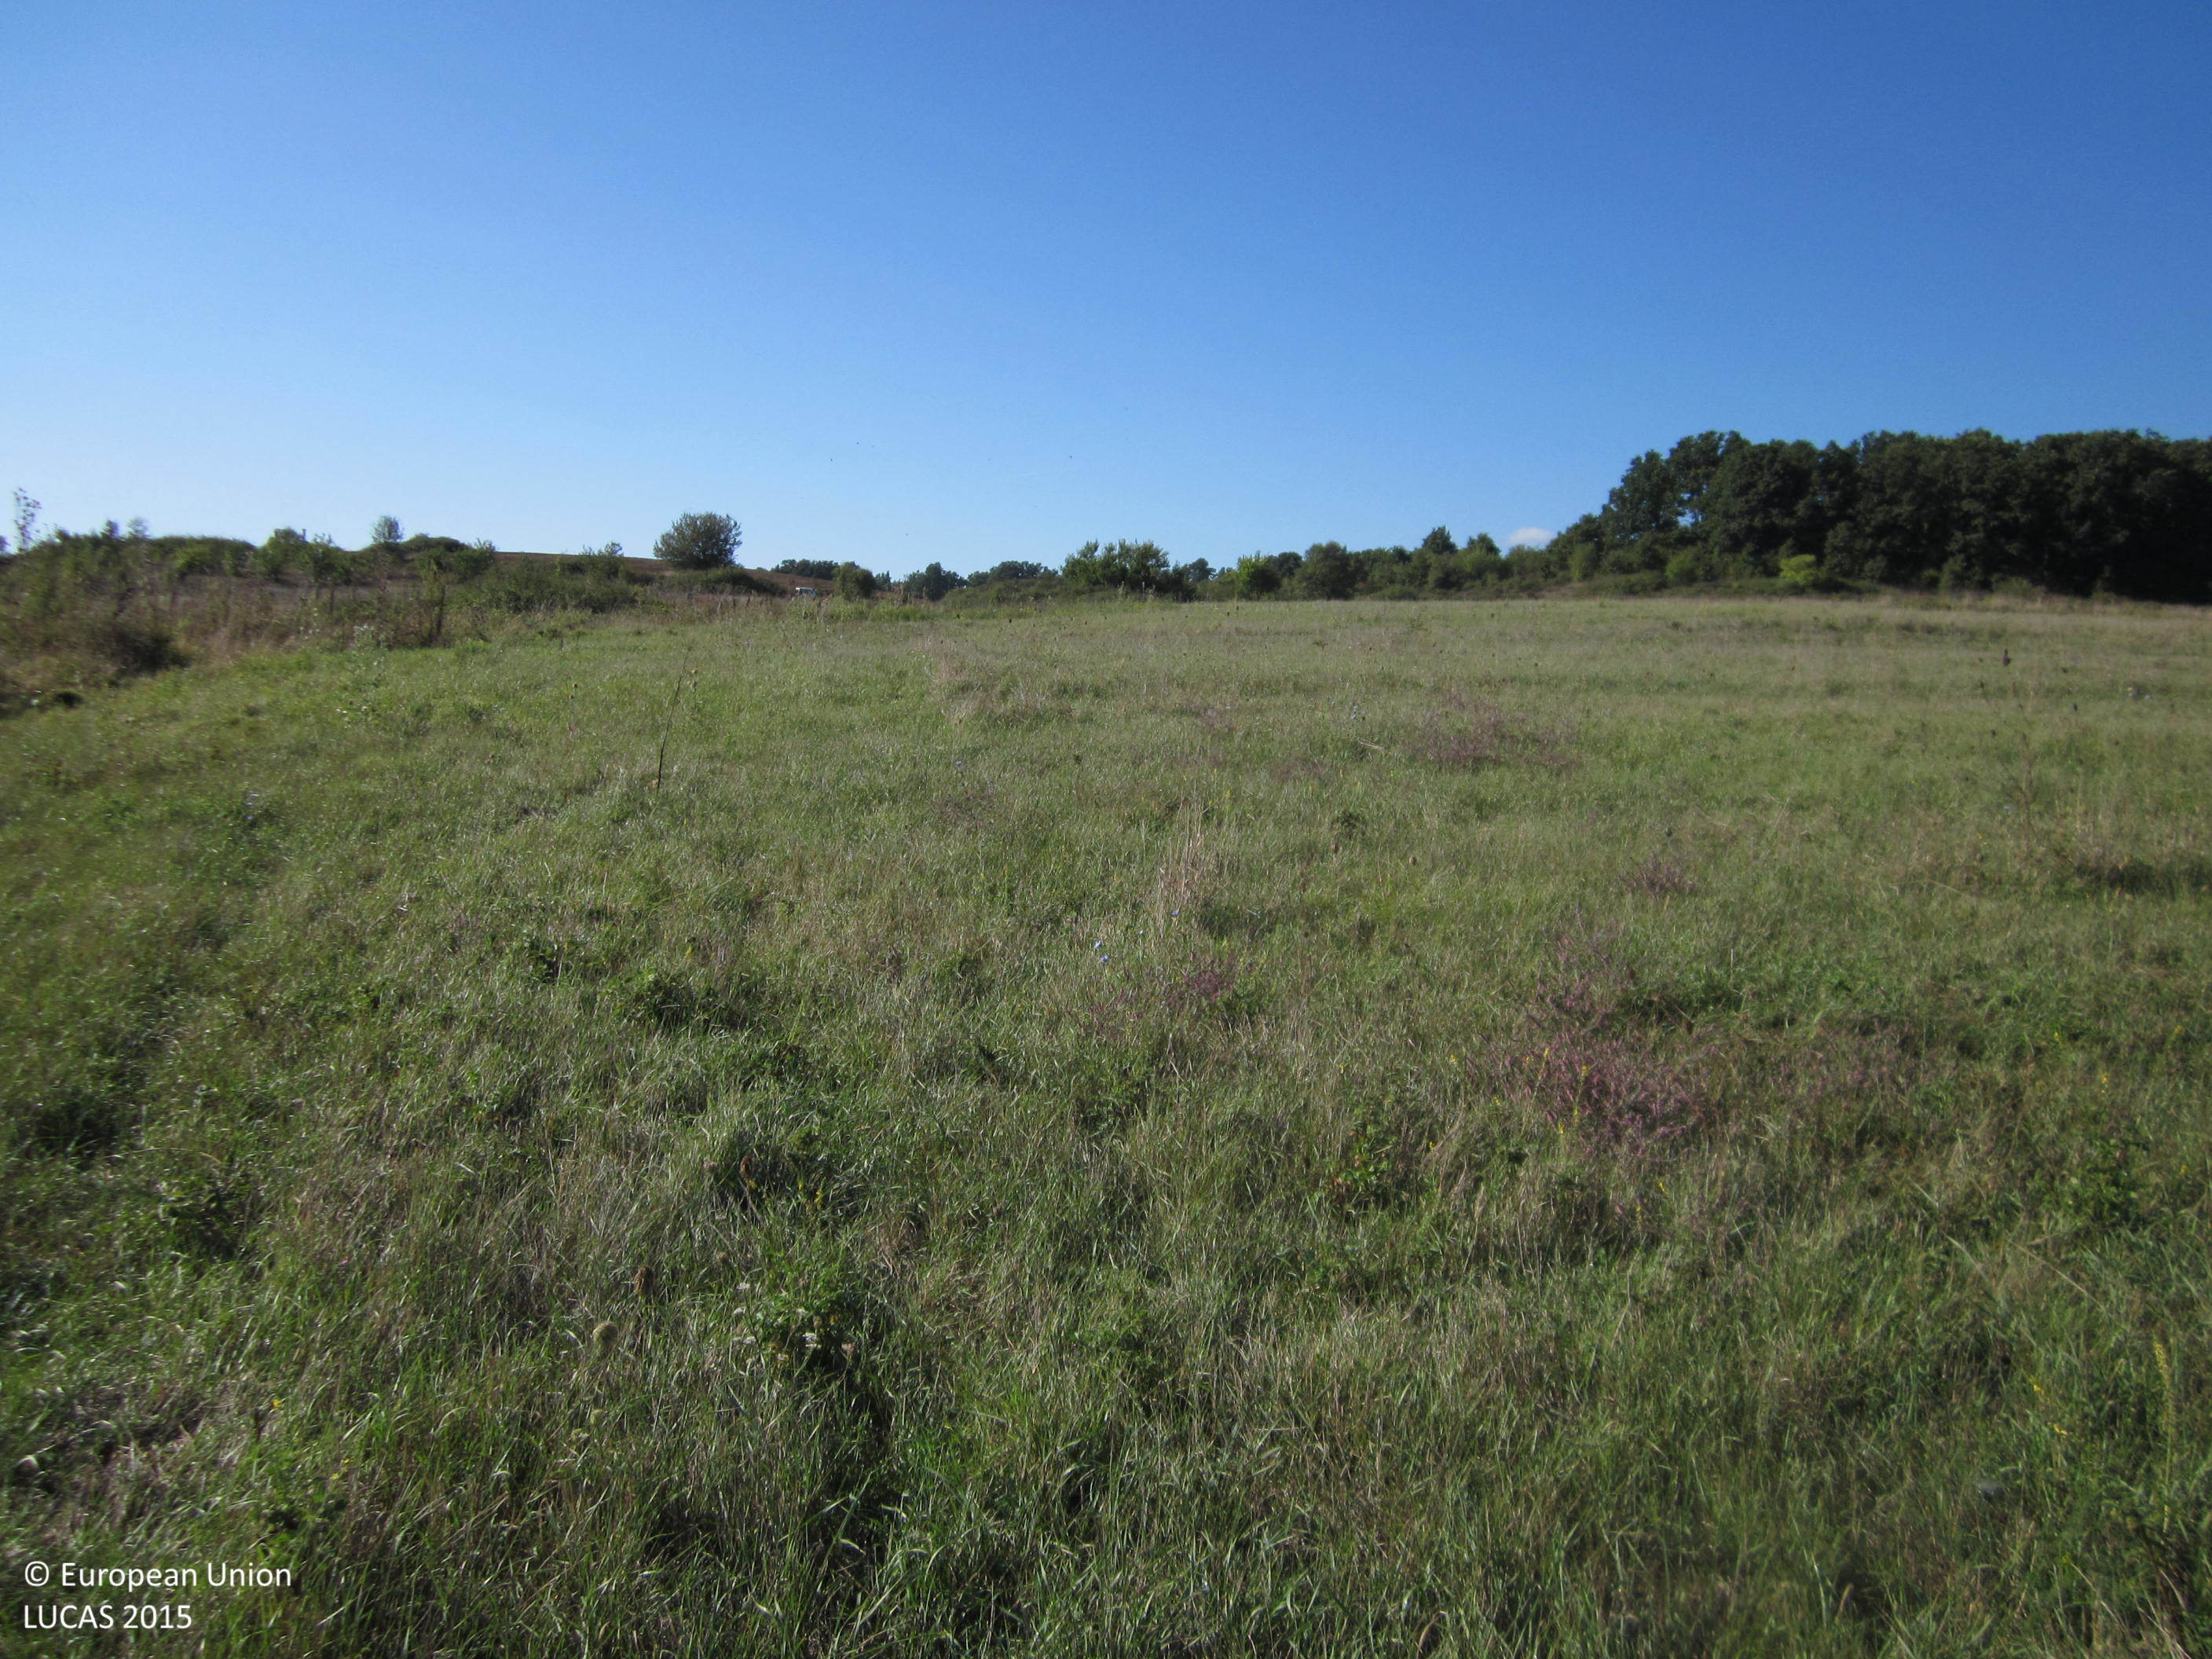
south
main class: Grassland
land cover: Grassland without tree/shrub cover
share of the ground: > 75 %
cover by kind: herbaceous plants 100 %
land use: Agriculture (excluding fallow land and kitchen gardens)
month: September
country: BG
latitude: 42.1794
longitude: 27.1133
